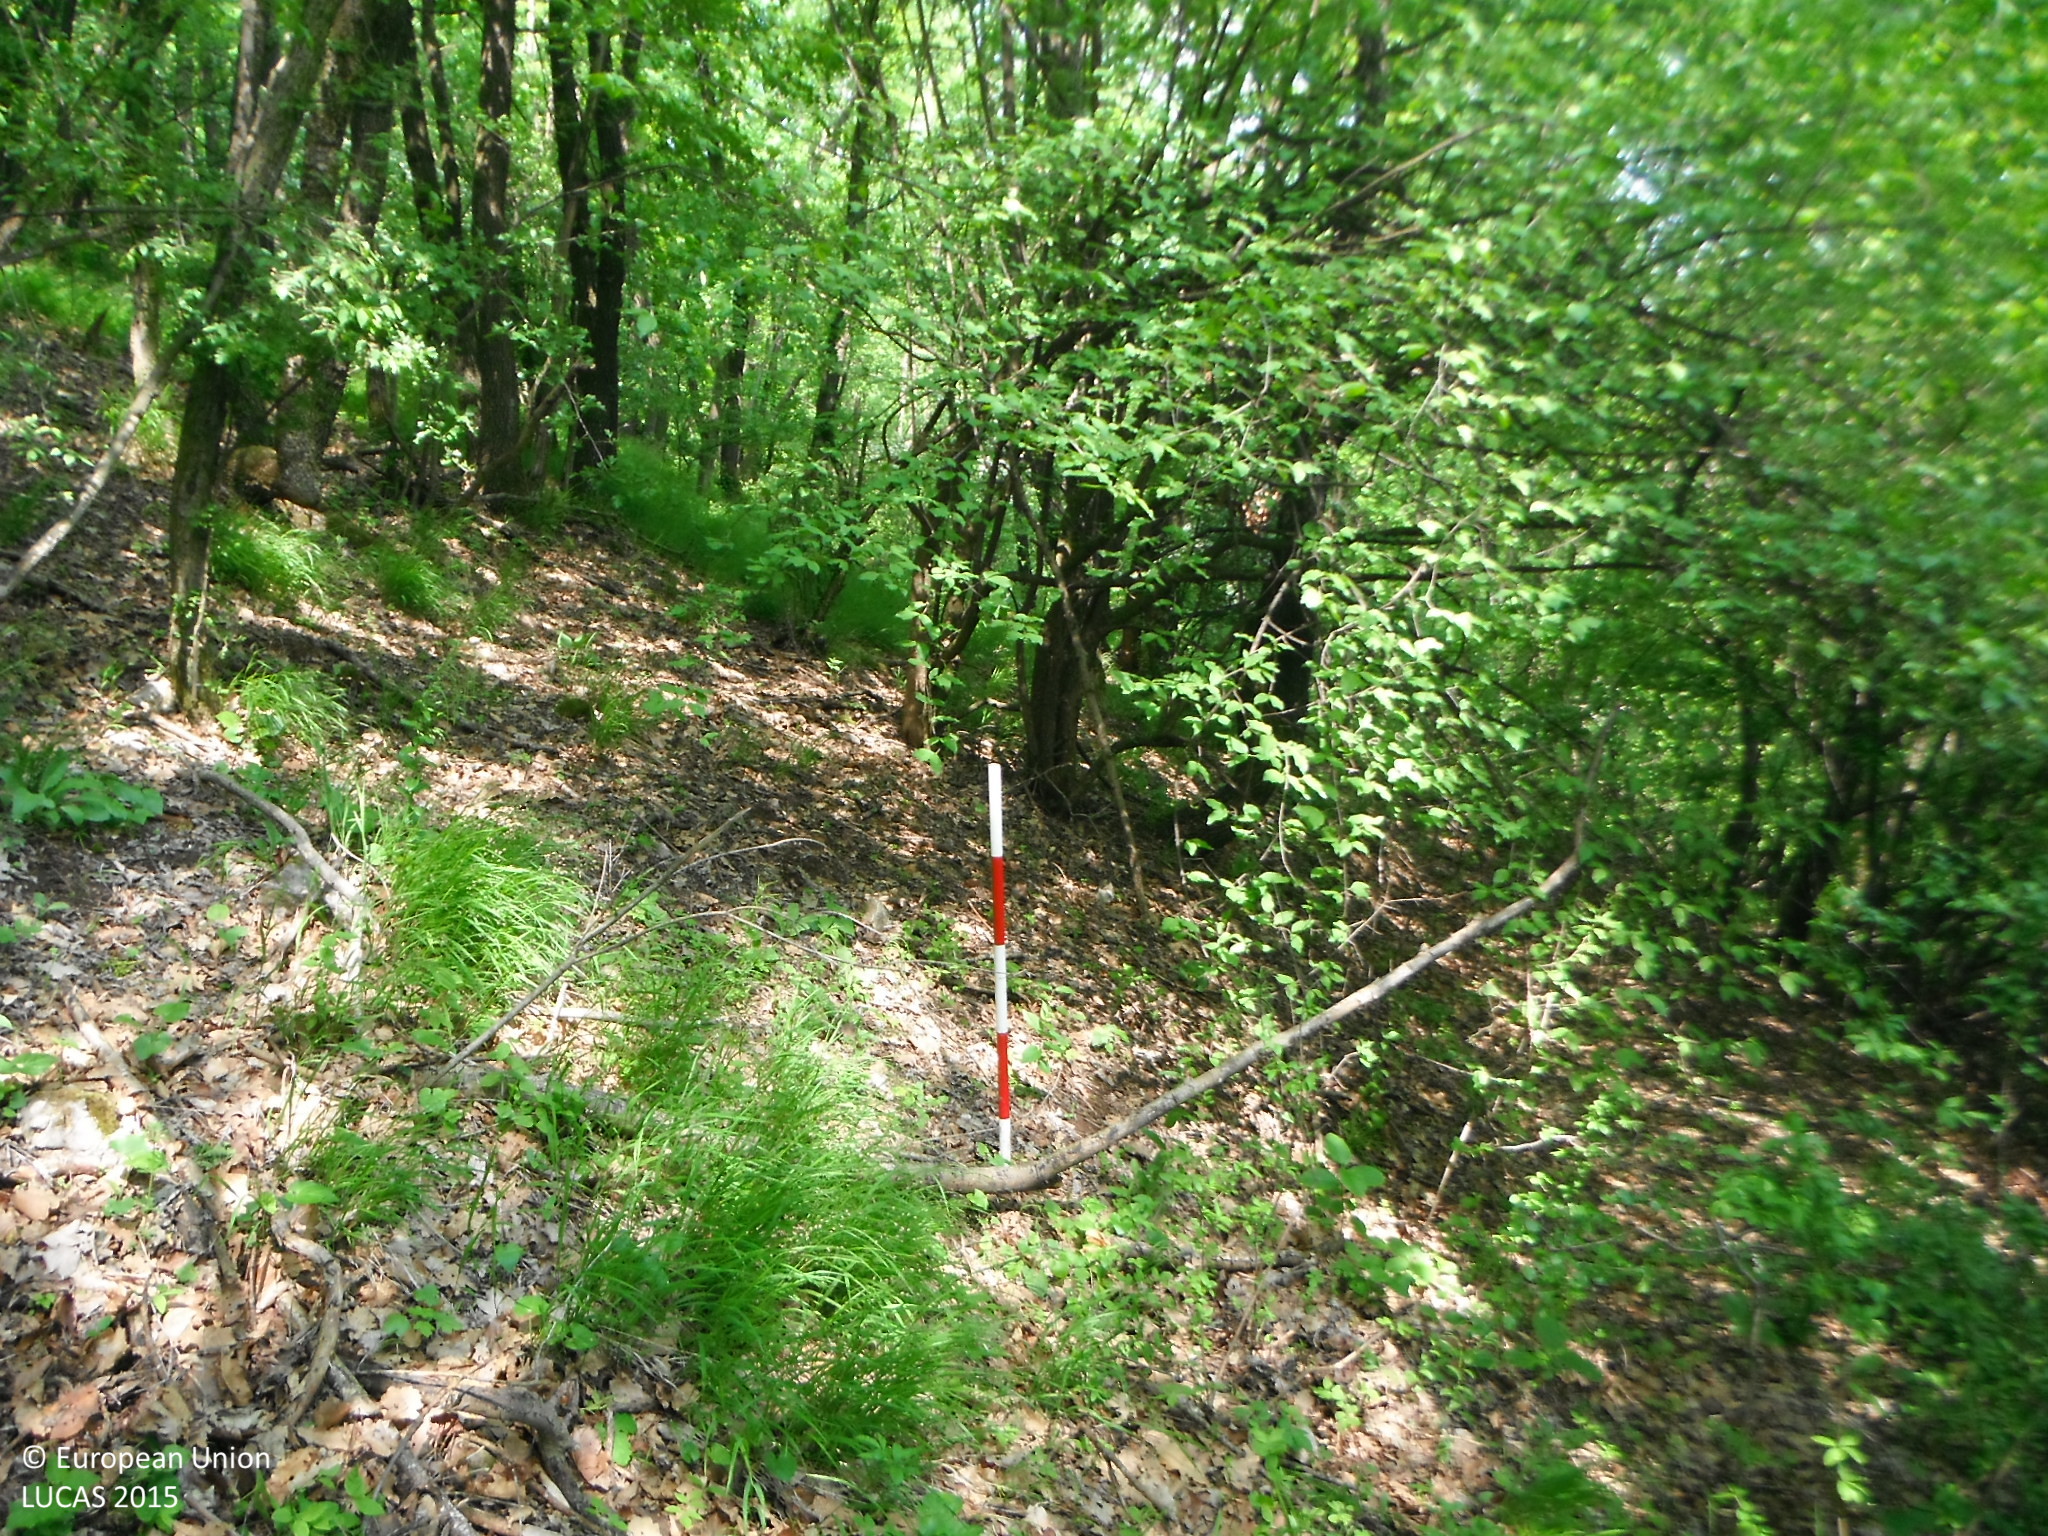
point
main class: Woodland
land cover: Broadleaved woodland
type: mesophytic deciduous forest
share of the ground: > 75 %
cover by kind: broadleaved forest trees 100 %
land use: Forestry
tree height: > 5 m
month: May
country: SK
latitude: 48.3593
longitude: 18.0982
